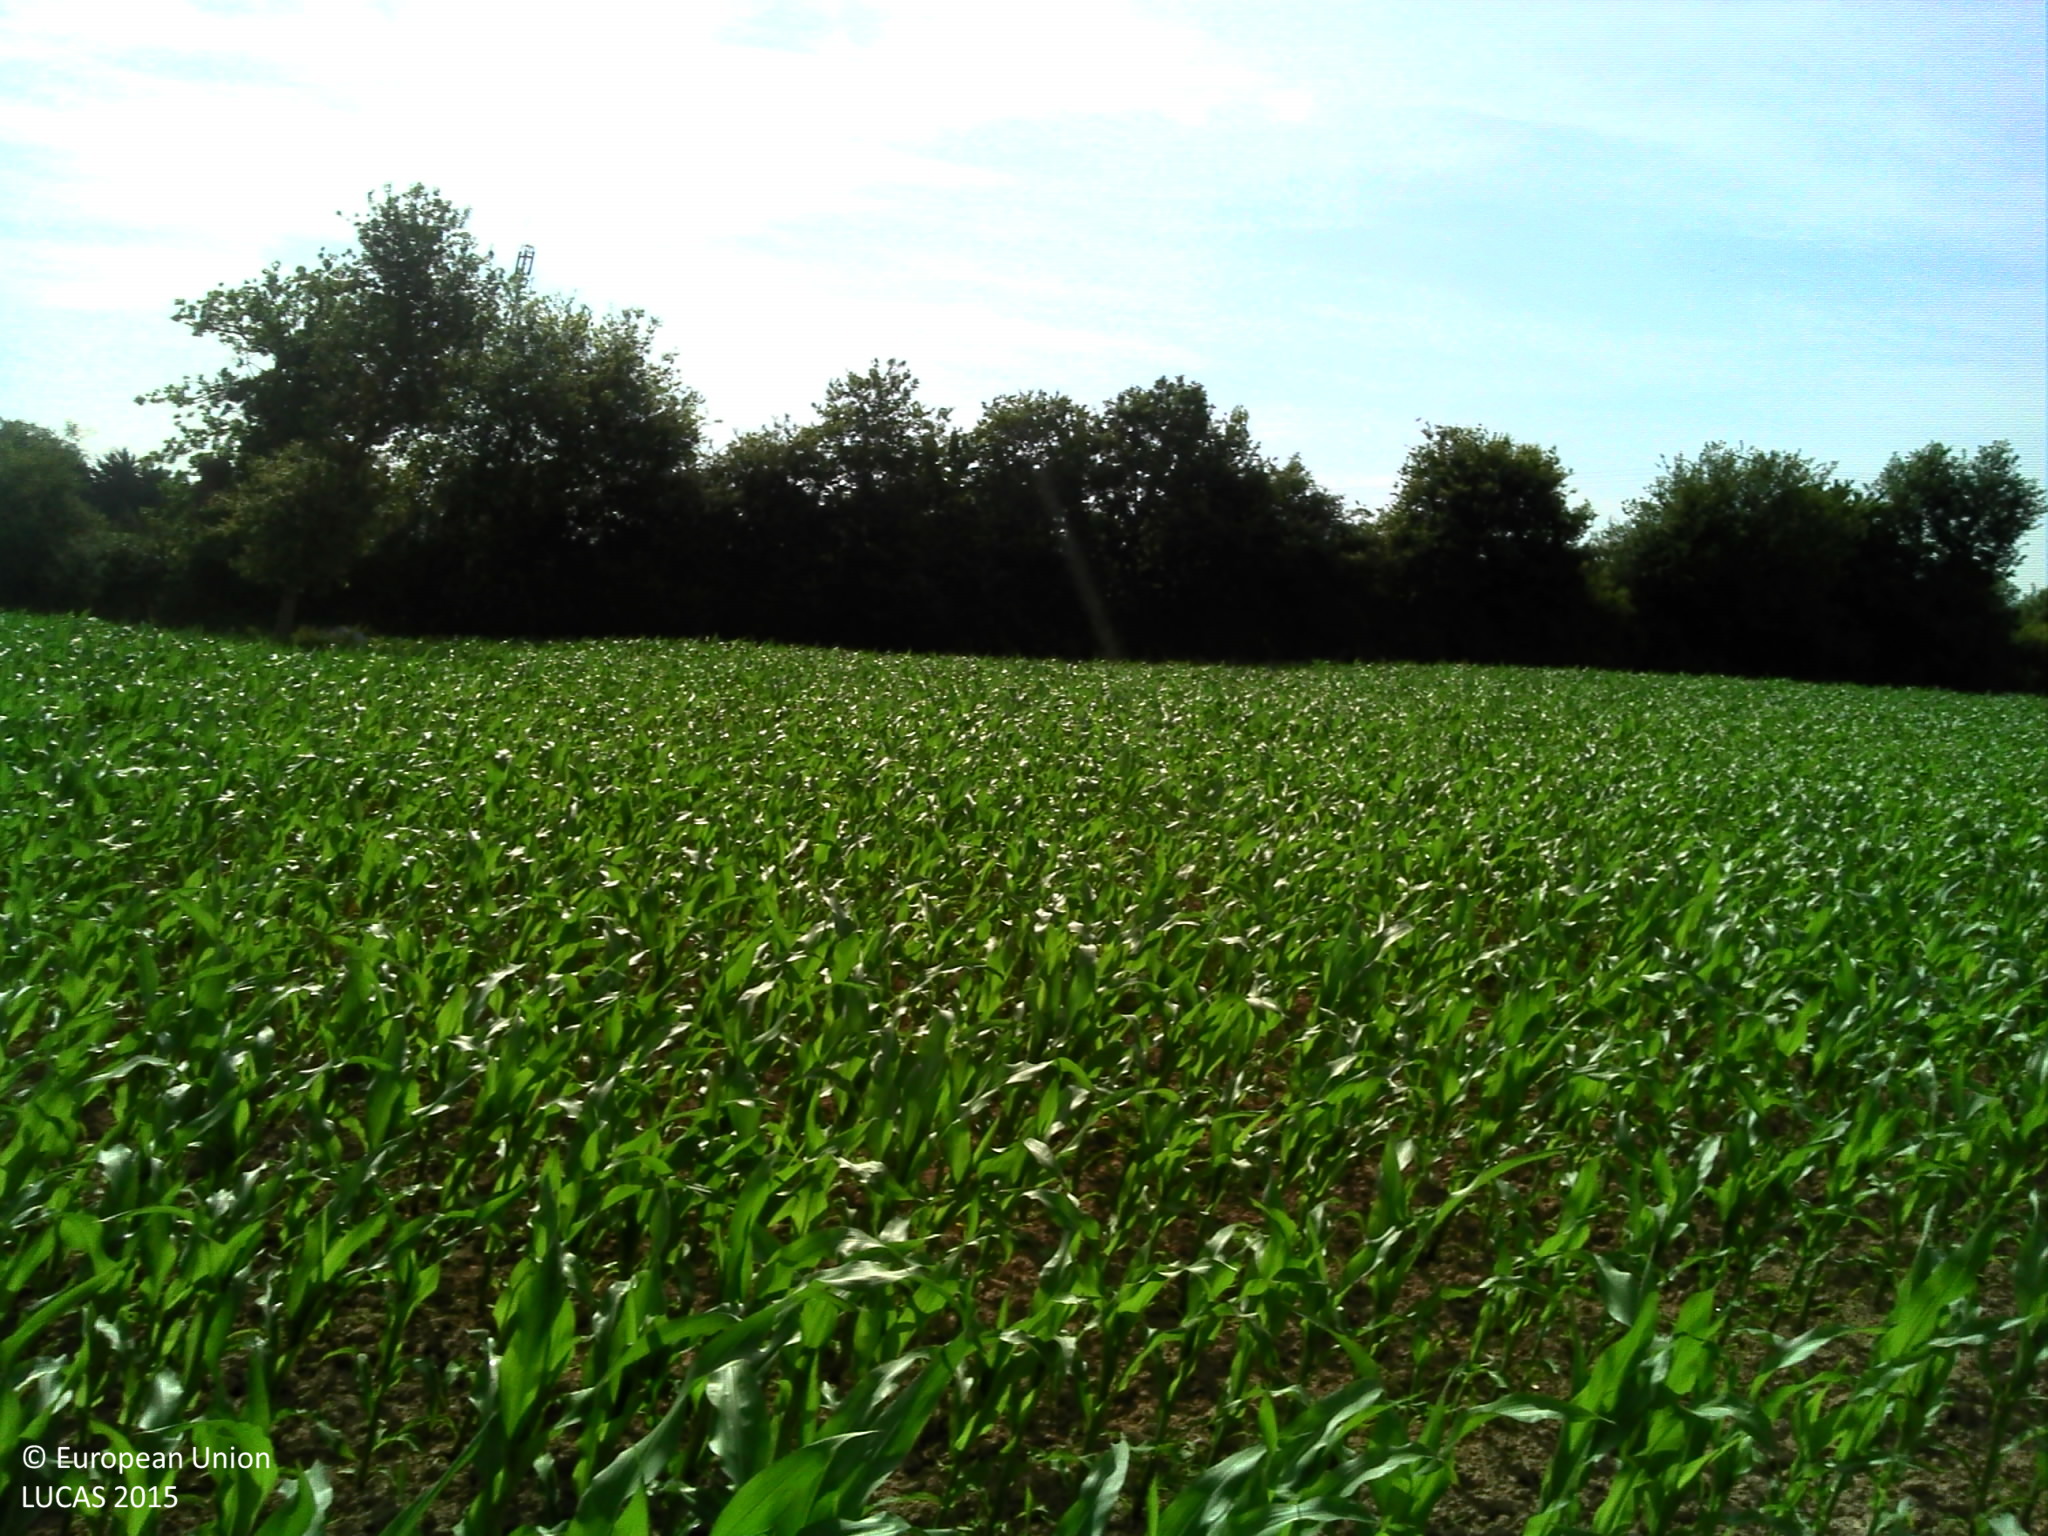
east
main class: Cropland
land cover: Maize
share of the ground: 10 - 25 %
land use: Agriculture (excluding fallow land and kitchen gardens)
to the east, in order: Maize; Abandoned hedges; Ditches and canals; Grass margins; Ditches and canals; Maize; Grass margins; Paved roads, cycling and walking lanes; Grass margins; Ditches and canals; Maize
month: June
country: FR
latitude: 48.0438
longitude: -1.9496
